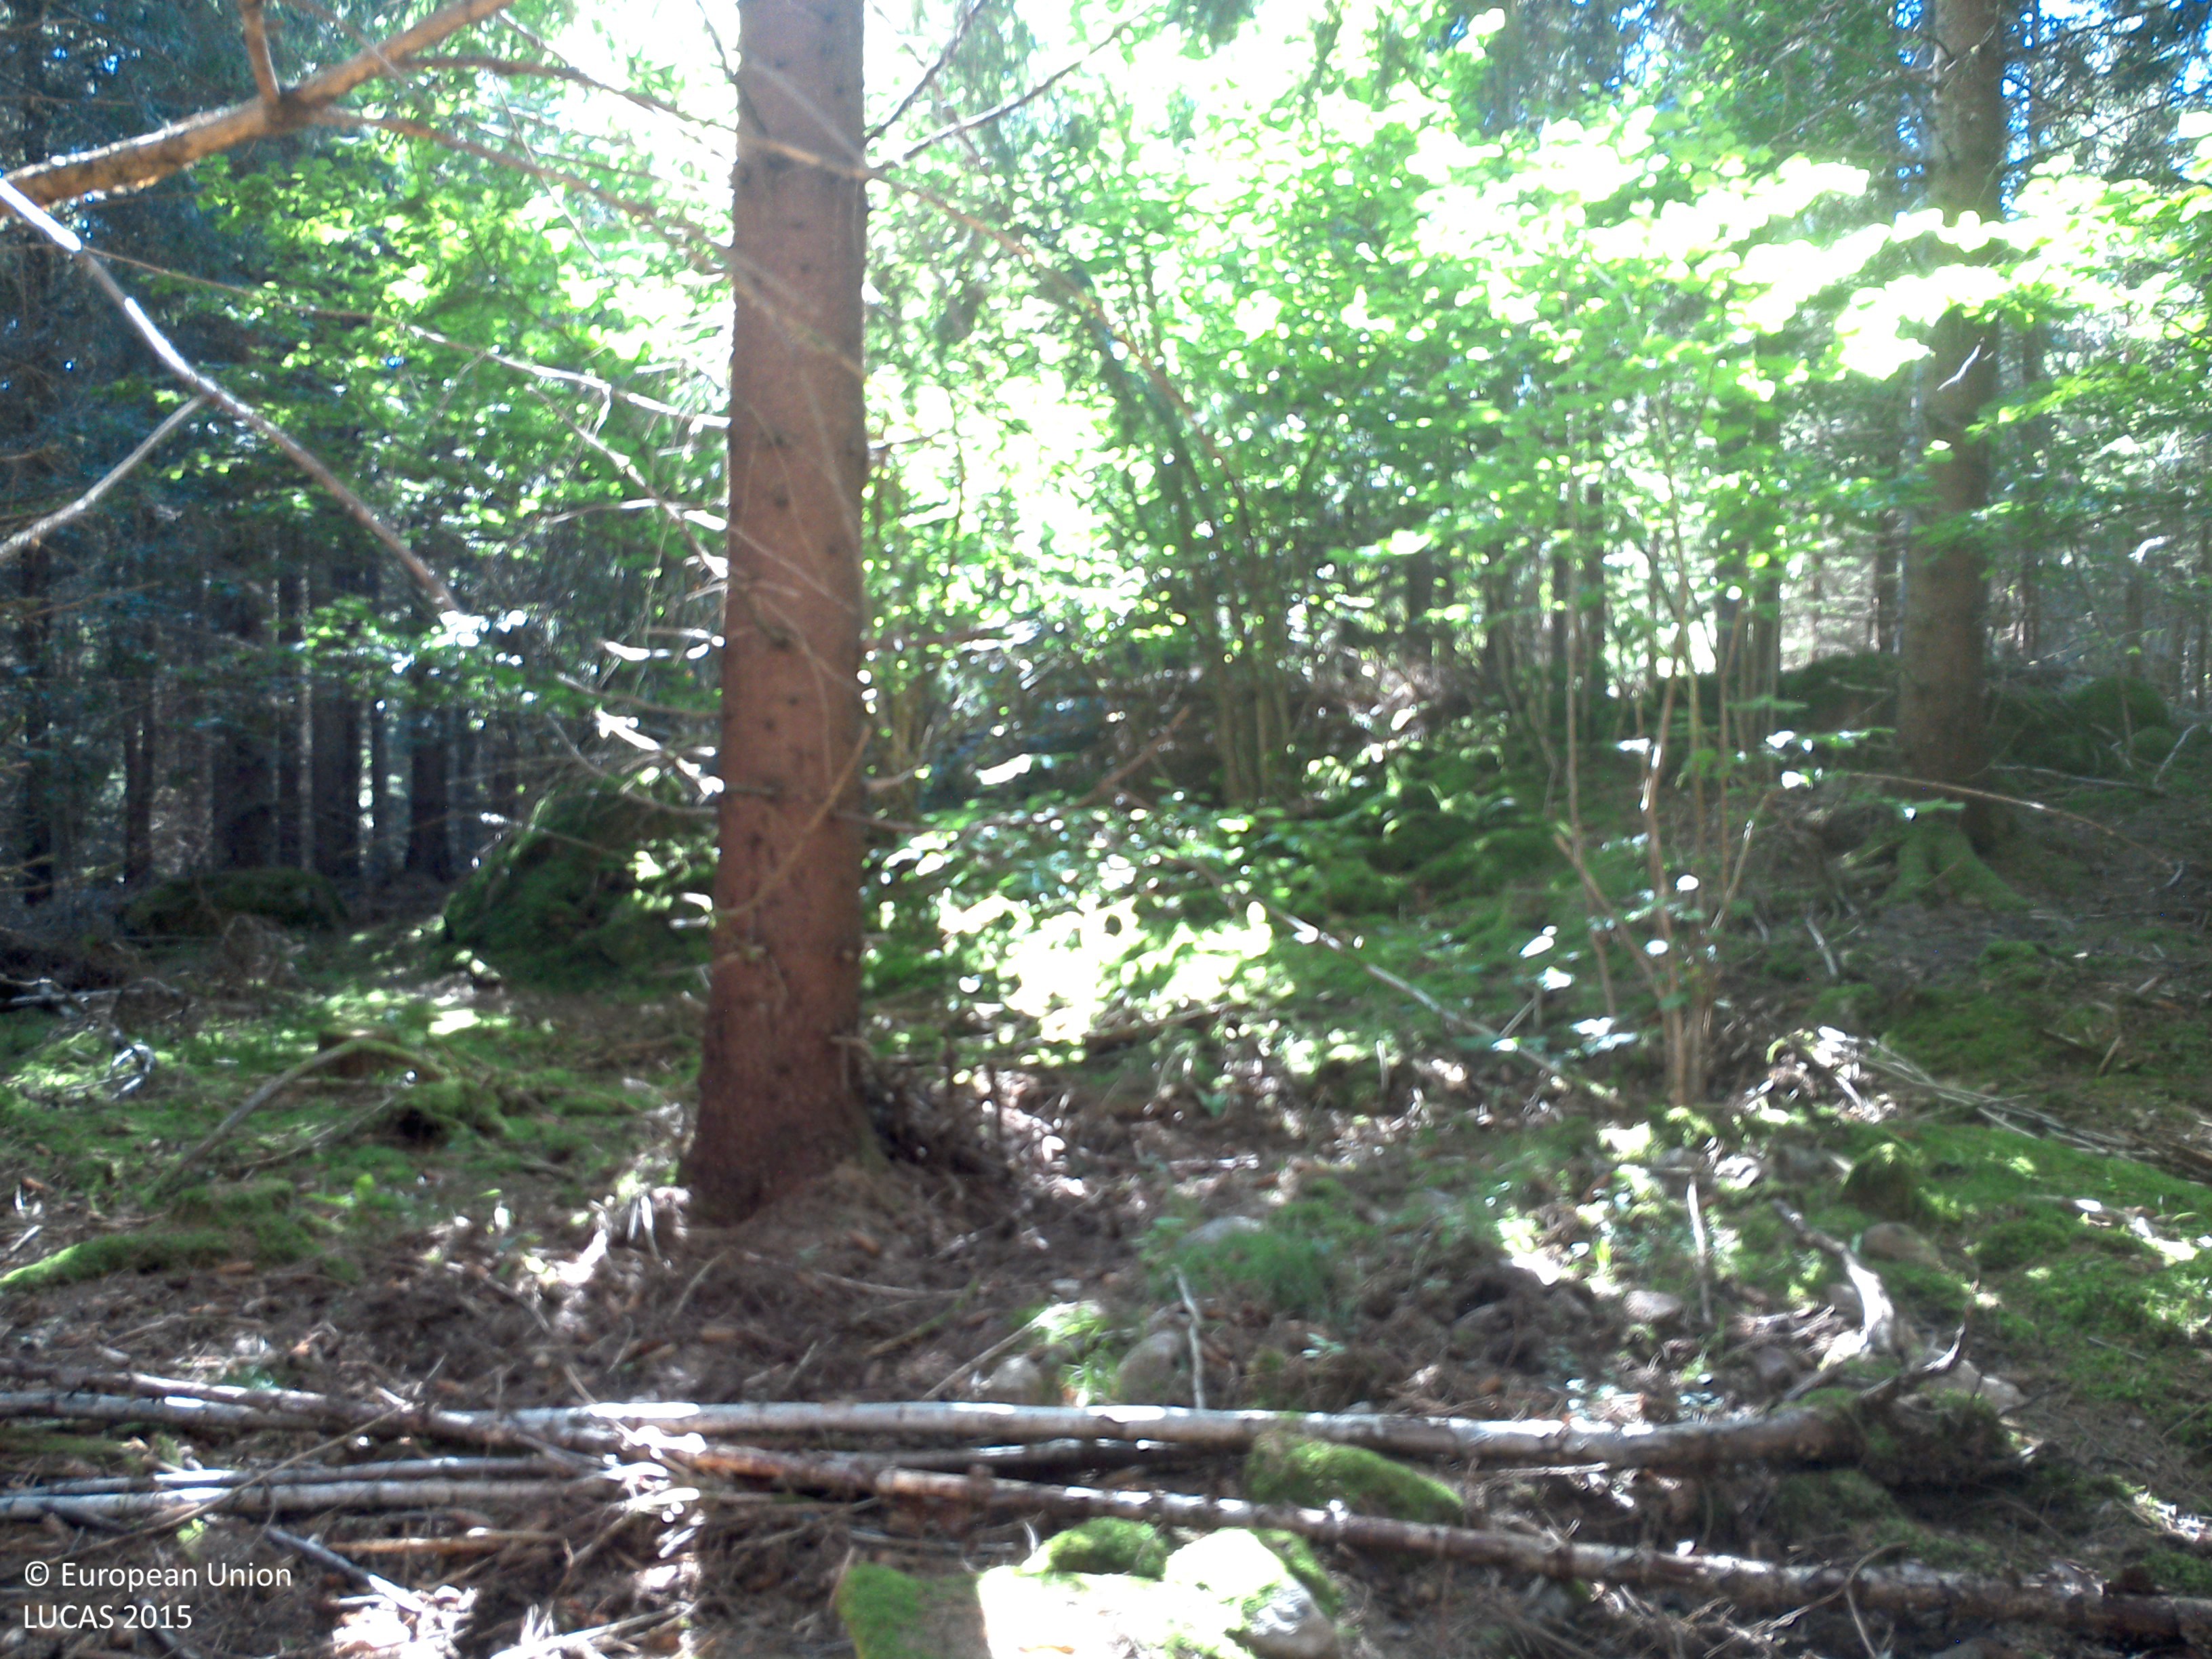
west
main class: Woodland
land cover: Spruce dominated coniferous woodland
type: boreal forest
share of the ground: > 75 %
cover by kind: coniferous forest trees 85 %, herbaceous plants 5 %, lichens and mosses 5 %, unconsolidated bare surface 5 %
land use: Forestry
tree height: > 5 m
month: August
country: SE
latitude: 57.8915
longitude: 15.4780
